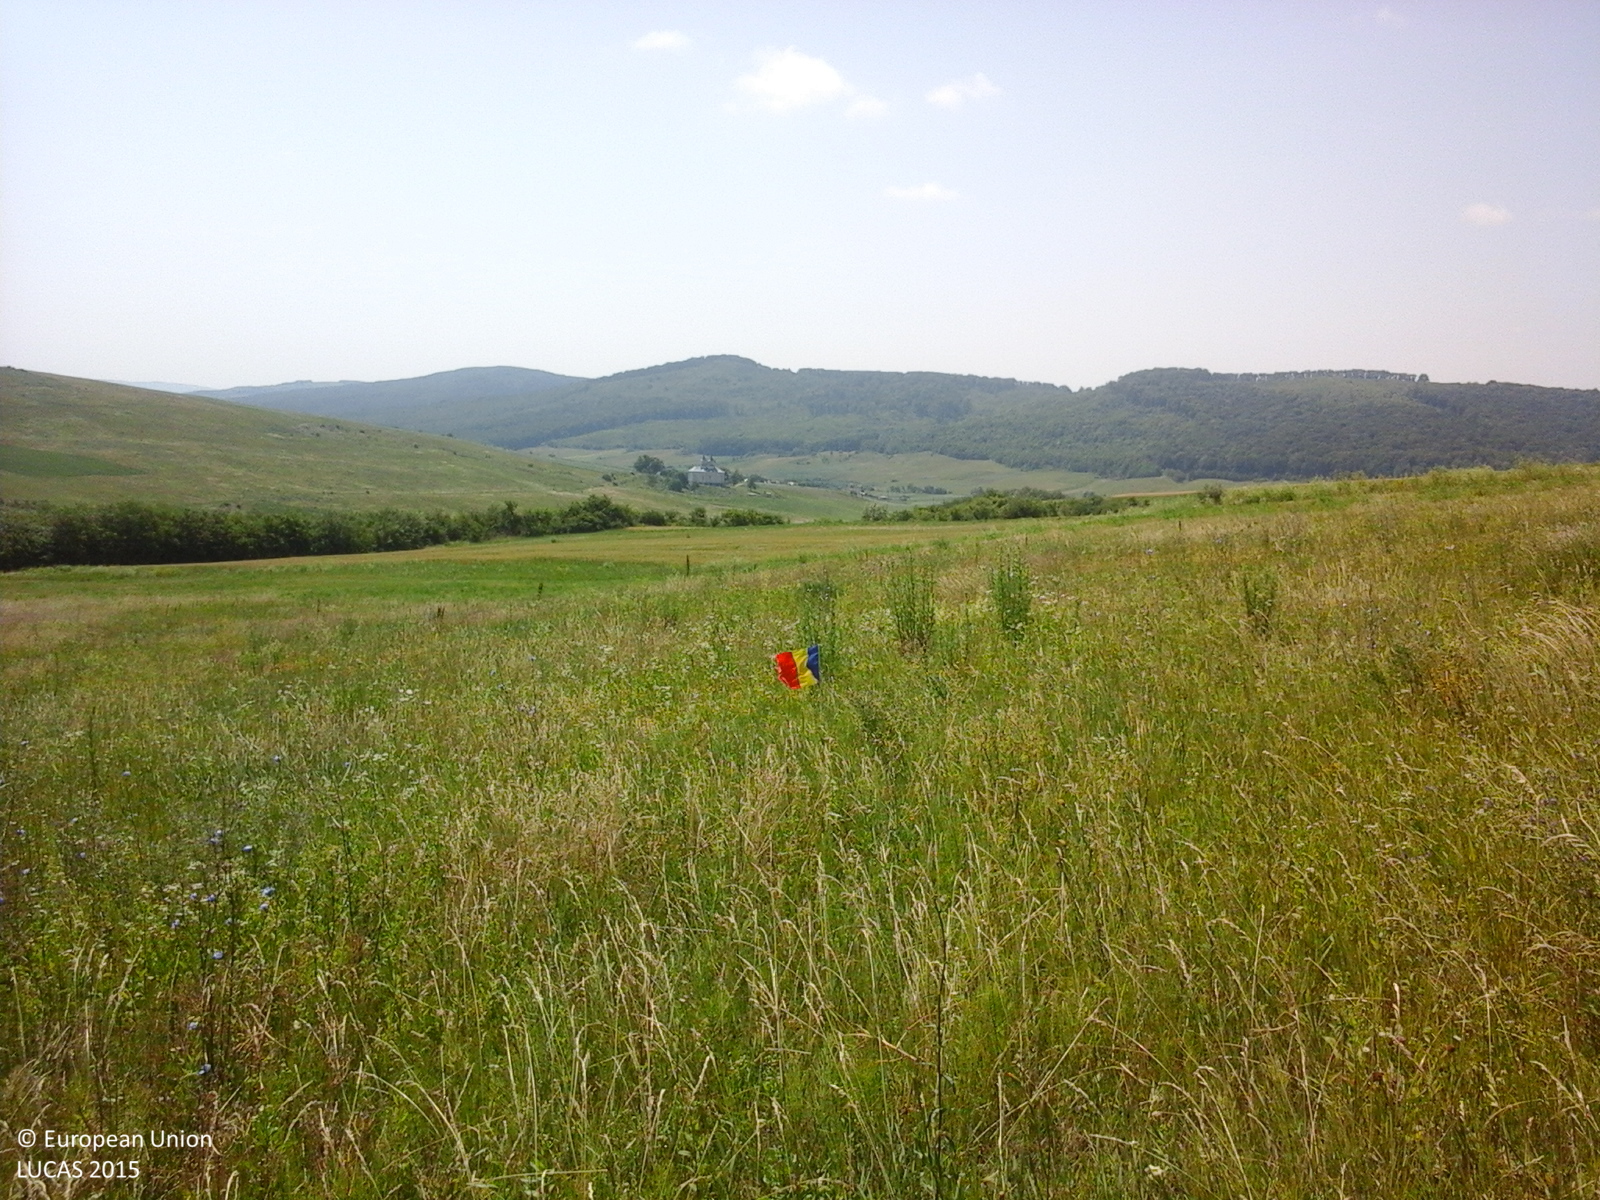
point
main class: Grassland
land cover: Grassland without tree/shrub cover
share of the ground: > 75 %
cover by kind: herbaceous plants 100 %
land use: Agriculture (excluding fallow land and kitchen gardens)
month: June
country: RO
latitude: 46.7199
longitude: 27.2569
